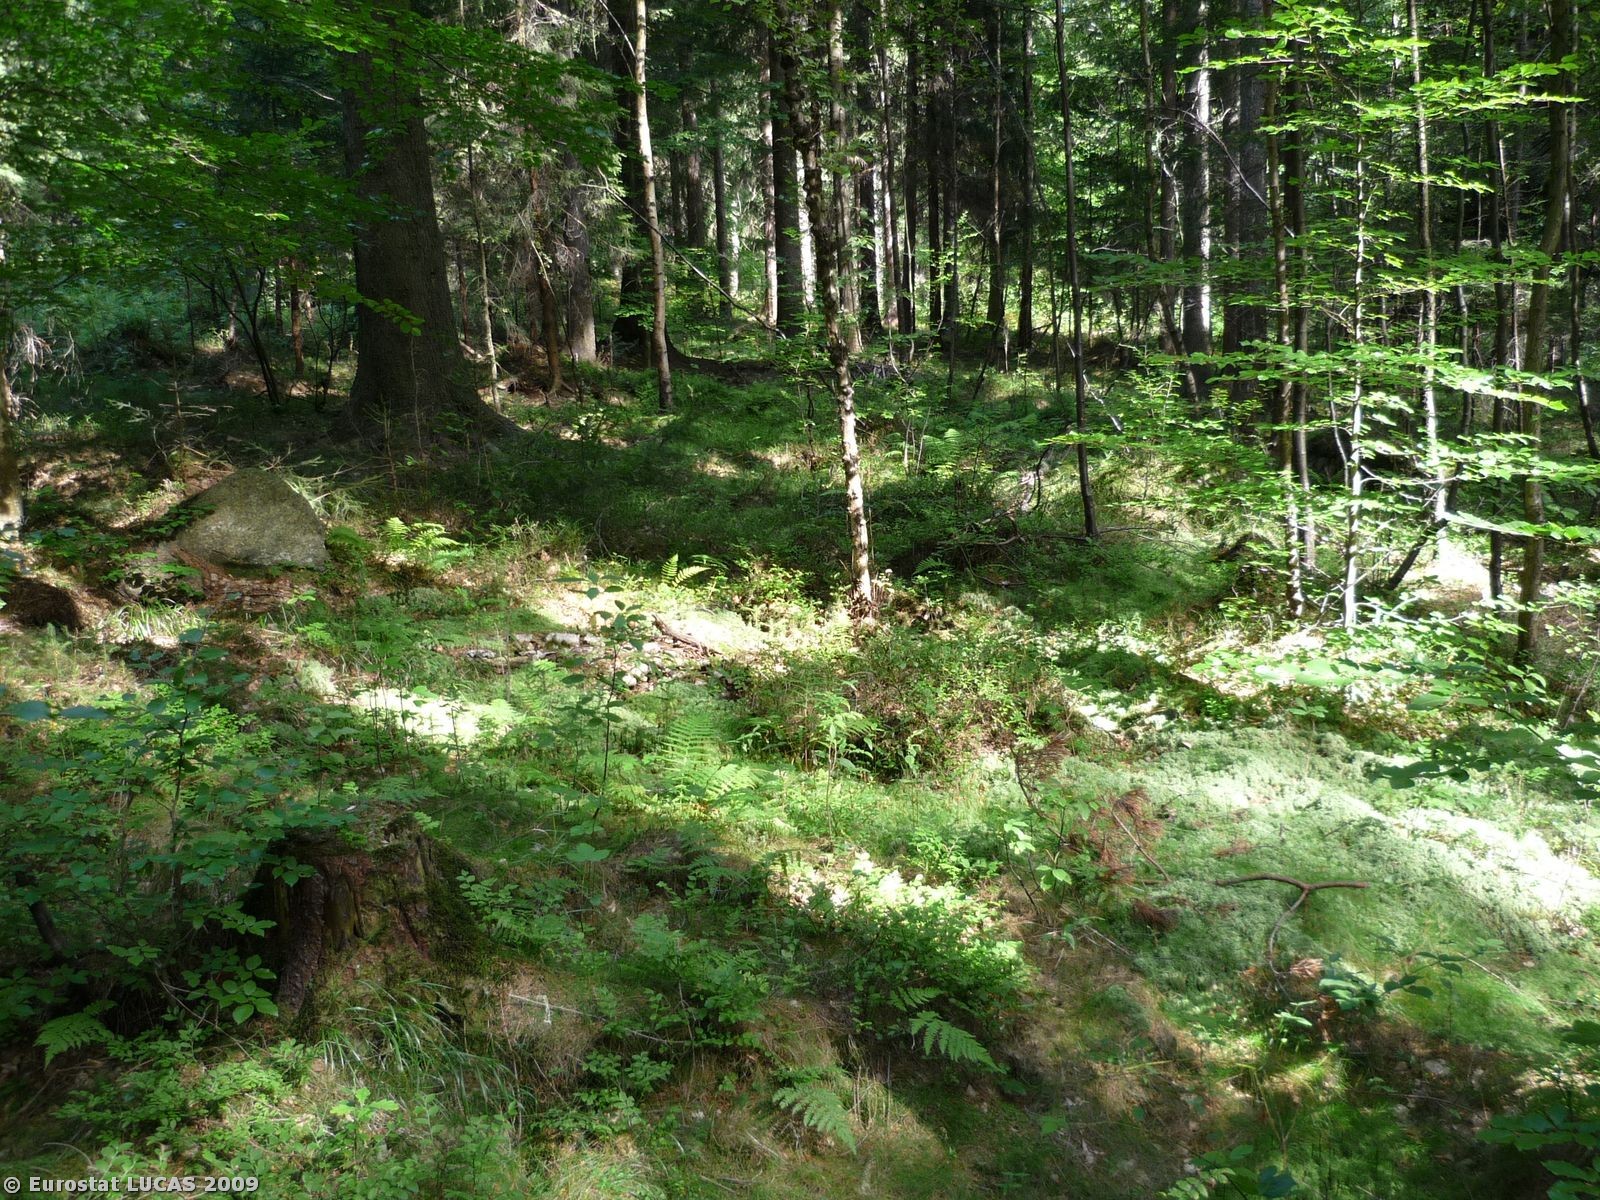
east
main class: Woodland
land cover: Coniferous woodland
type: hemiboreal forest and nemoral coniferous forest and mixed broadleaved-coniferous forest
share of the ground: > 75 %
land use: Forestry
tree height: > 5 m
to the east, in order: Coniferous woodland; Mixed woodland; Grassland without tree/shrub cover
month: August
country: PL
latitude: 50.8597
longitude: 15.5593
